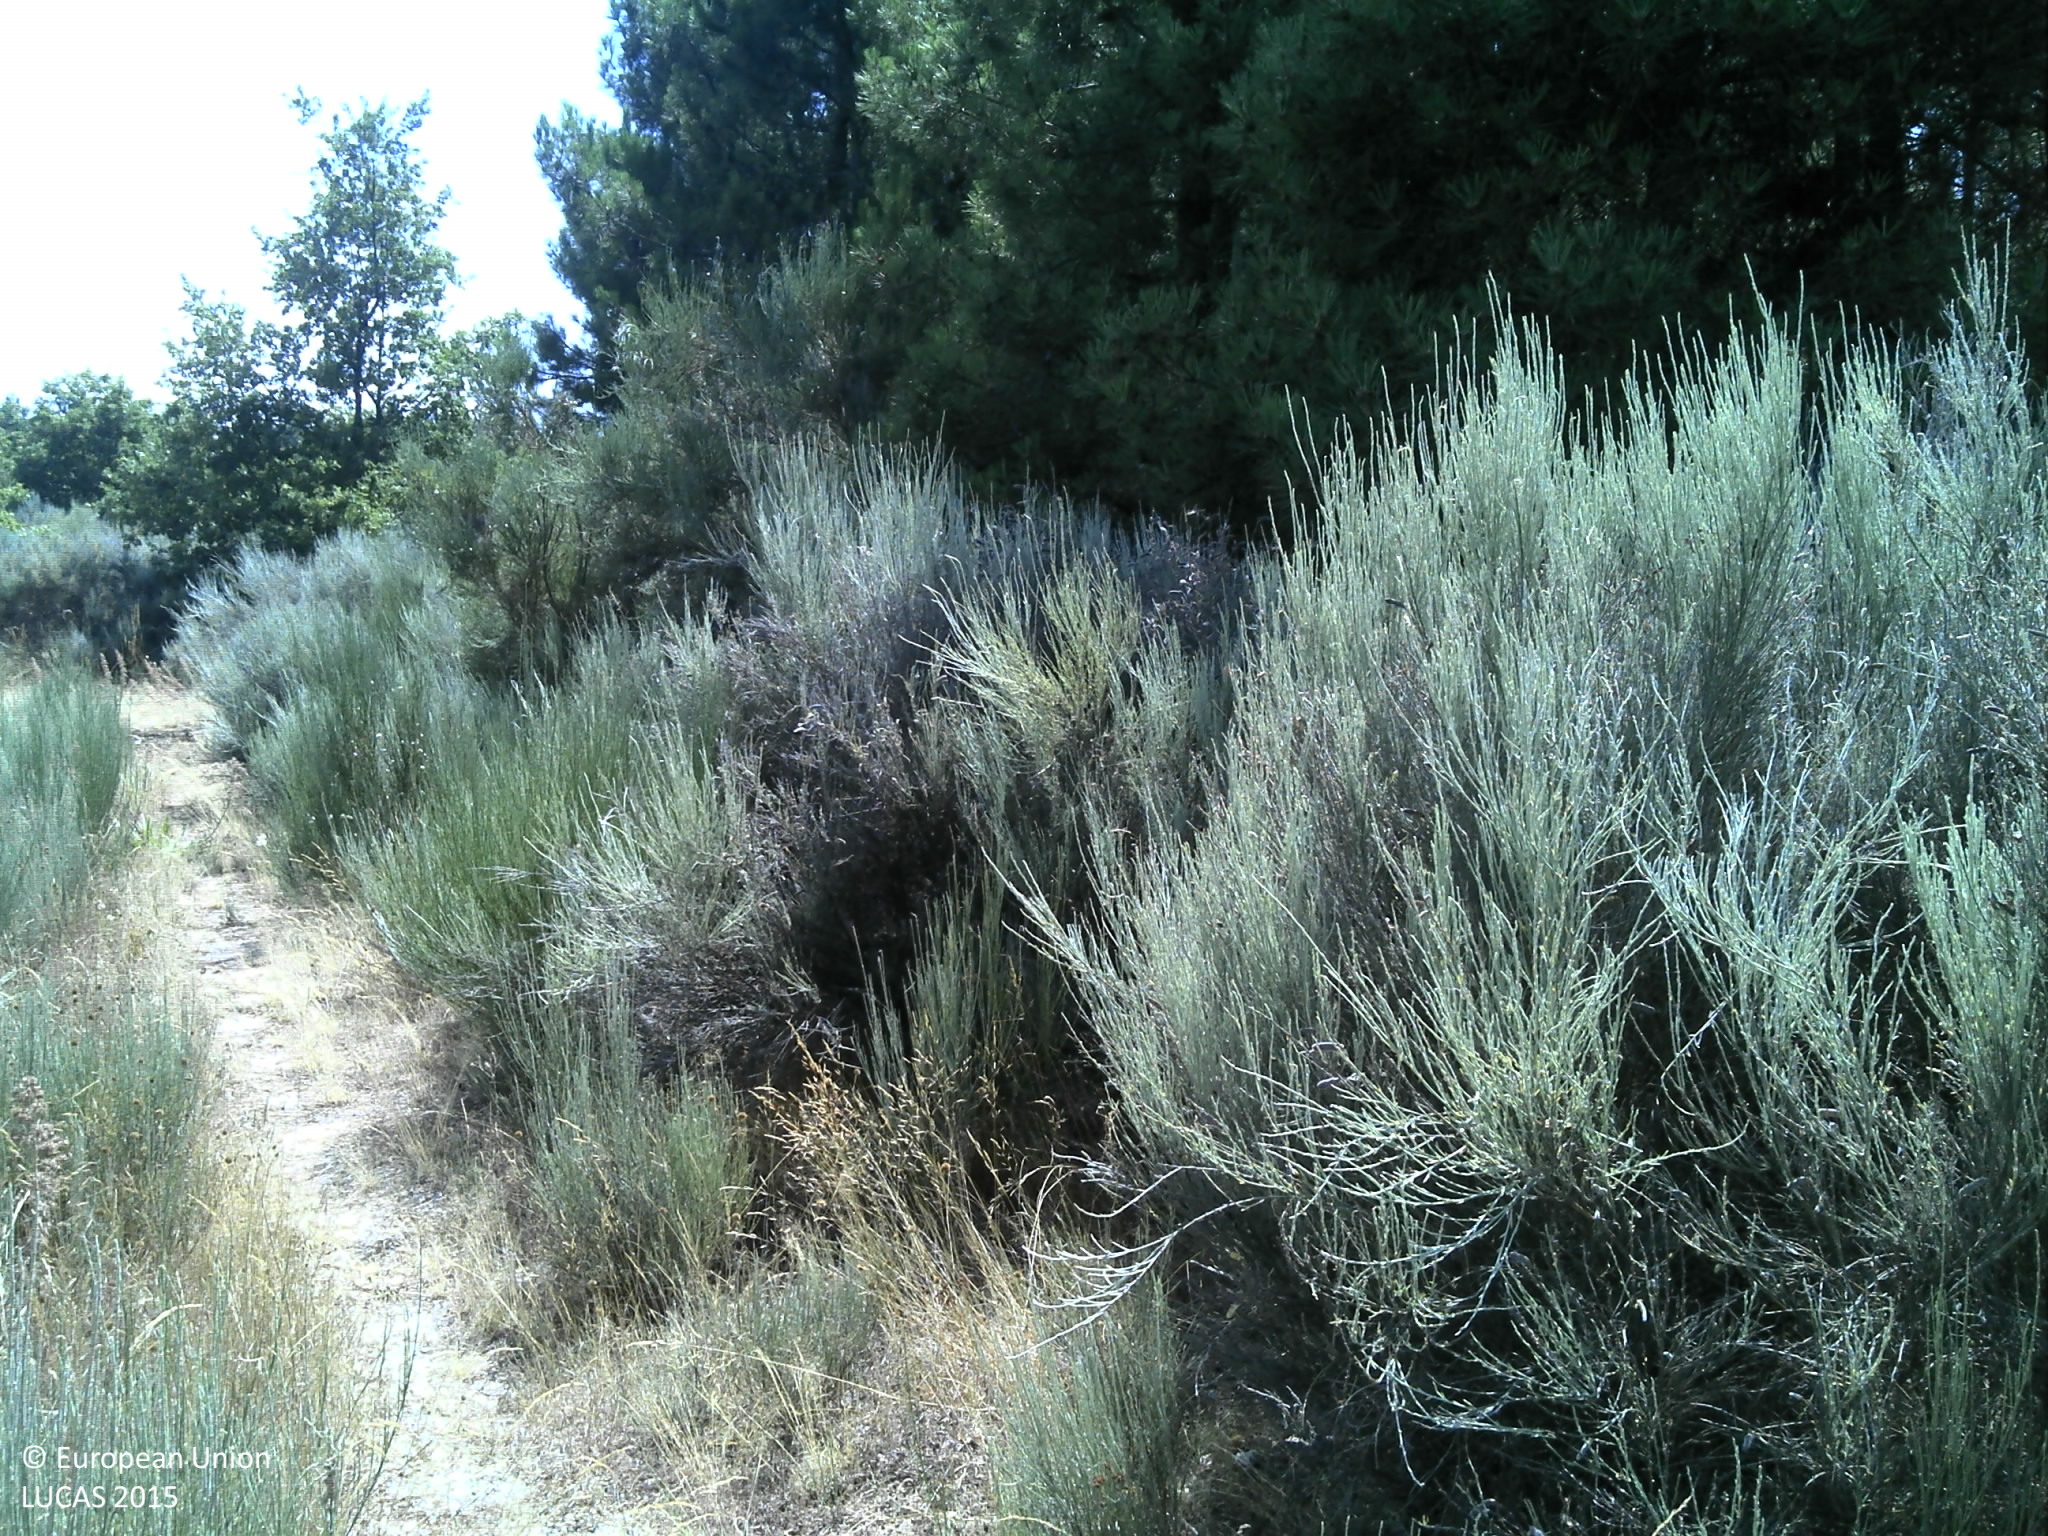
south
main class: Shrubland
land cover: Shrubland with sparse tree cover
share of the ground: > 75 %
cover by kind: shrubs 95 %, coniferous forest trees 5 %
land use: Abandoned areas
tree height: > 5 m
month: July
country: PT
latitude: 40.8310
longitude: -7.3426
